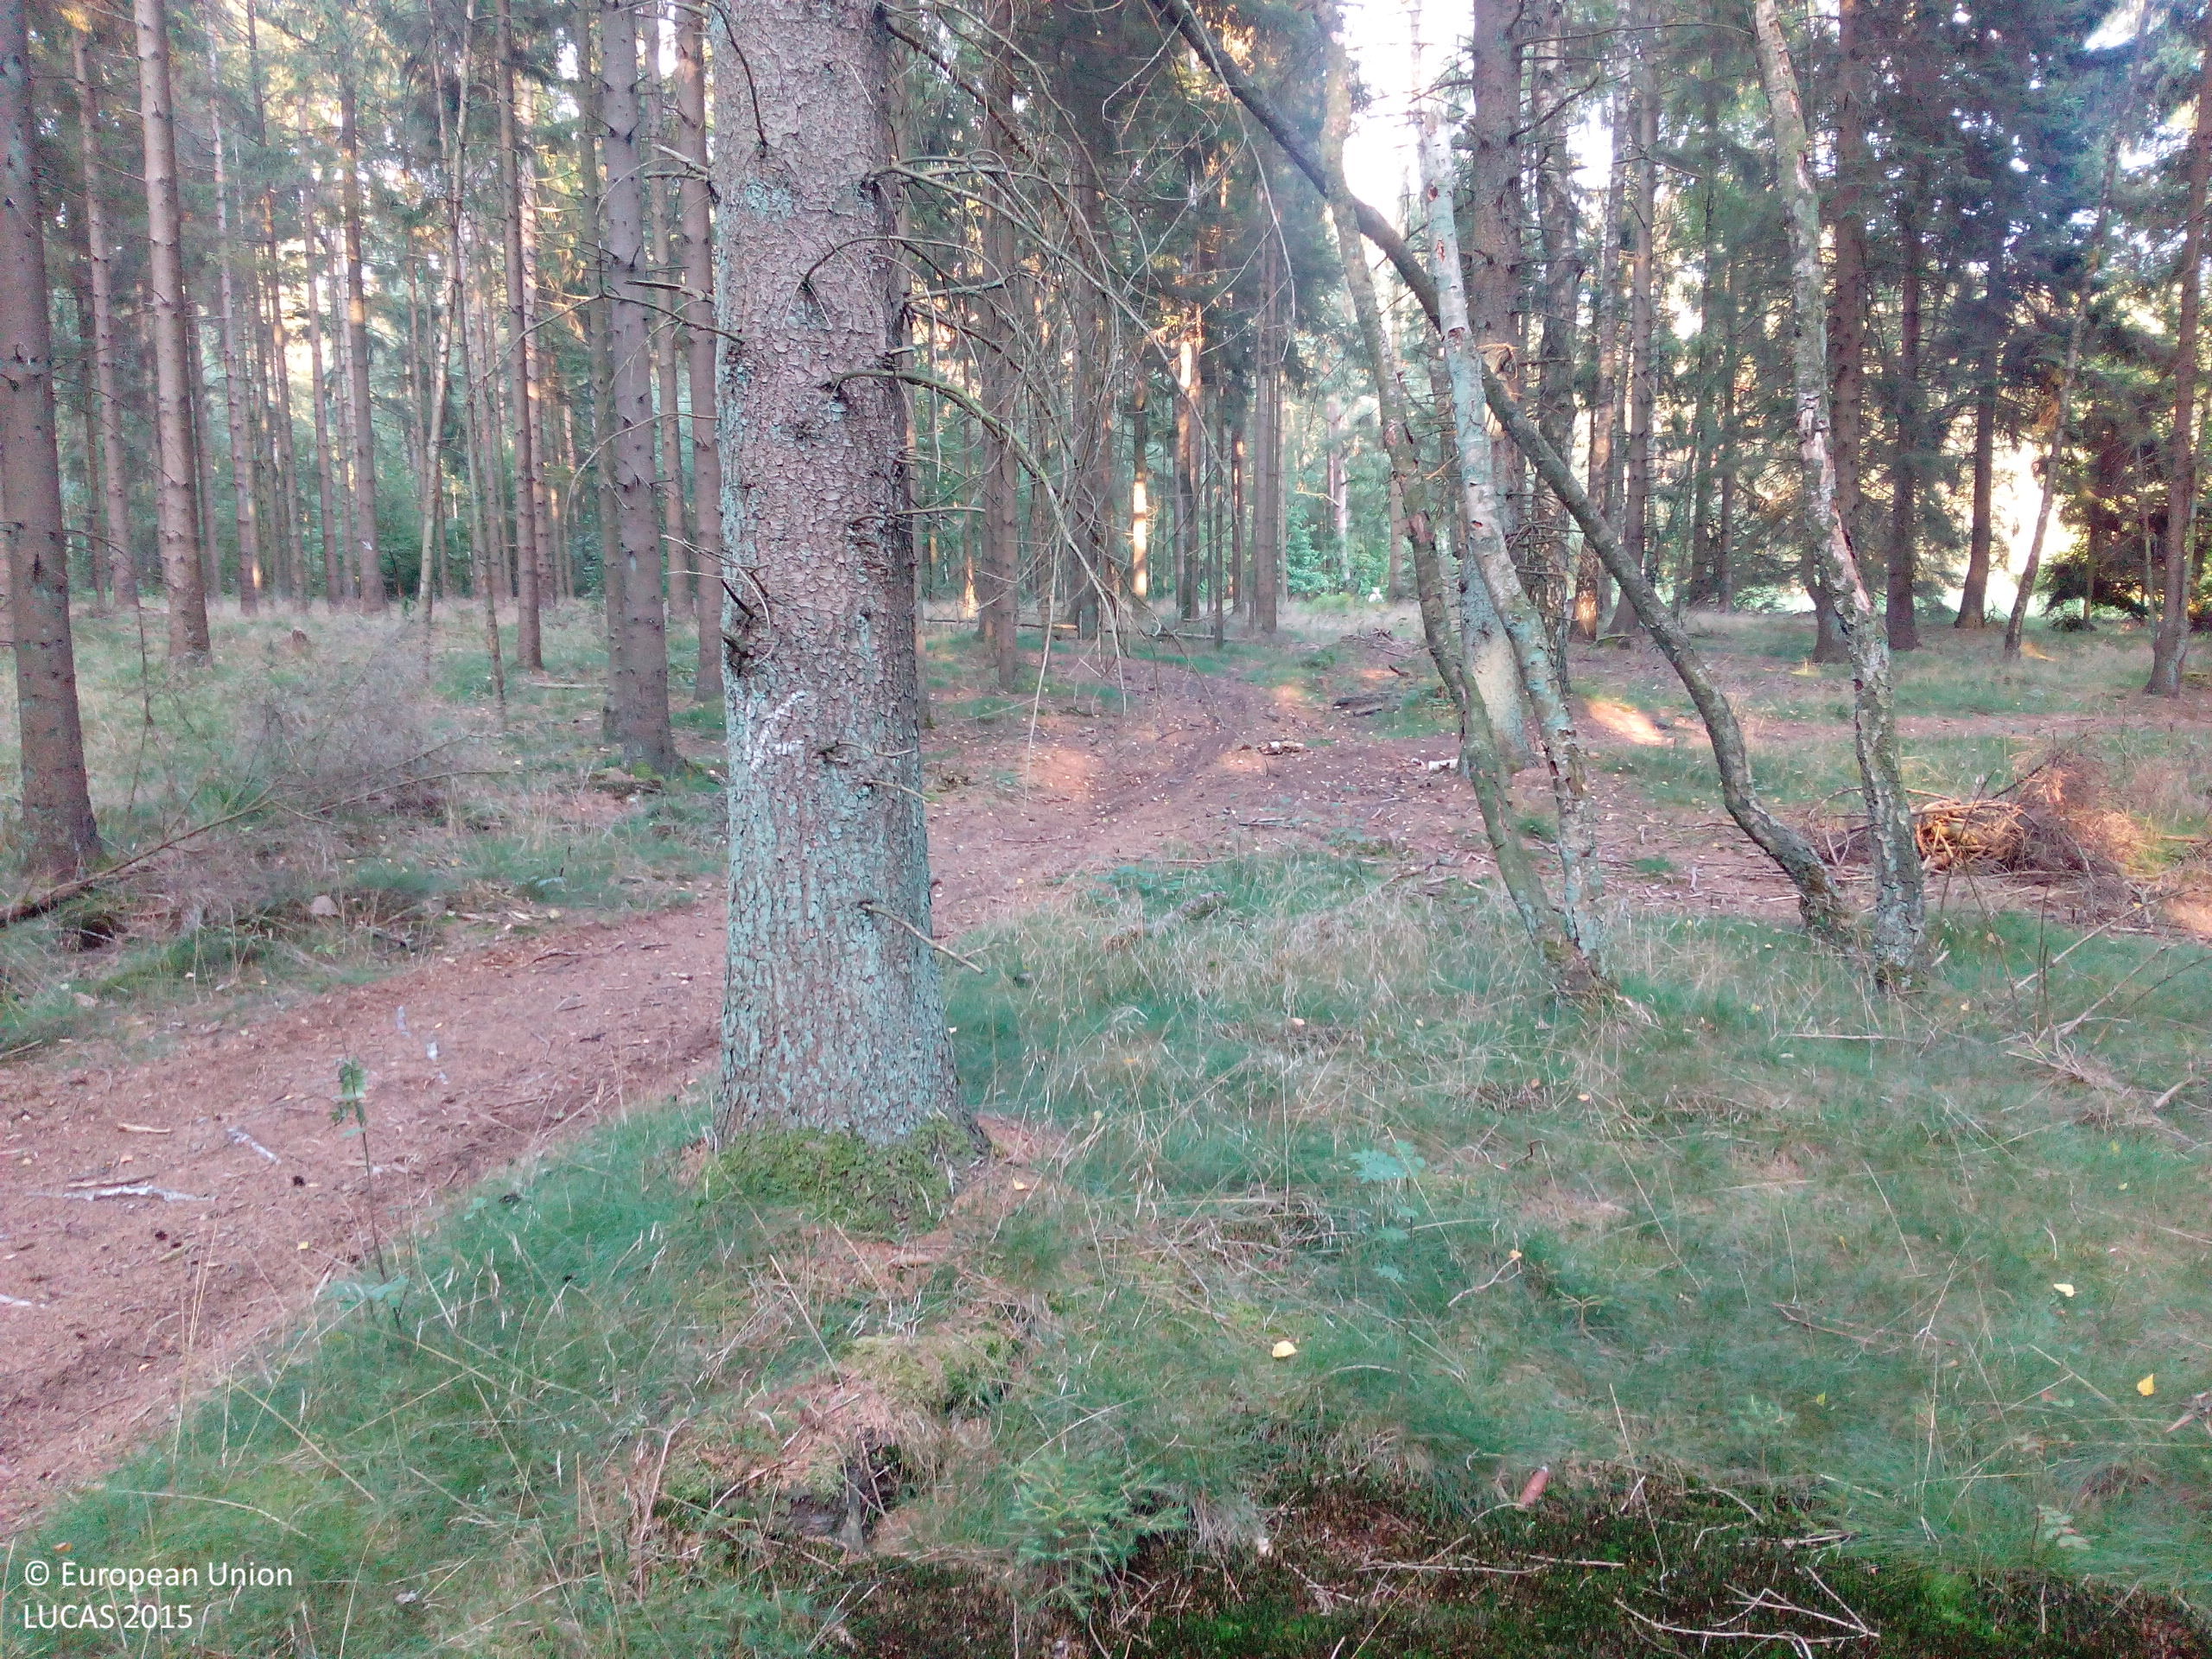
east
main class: Woodland
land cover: Spruce dominated coniferous woodland
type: hemiboreal forest and nemoral coniferous forest and mixed broadleaved-coniferous forest
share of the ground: > 75 %
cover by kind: coniferous forest trees 75 %, herbaceous plants 20 %, unconsolidated bare surface 5 %
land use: Forestry
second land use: Amenities, museums, leisure
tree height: > 5 m
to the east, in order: Spruce dominated coniferous woodland; Tracks; Pine dominated coniferous woodland; Tracks; Spontaneously vegetated surfaces; Pine dominated coniferous woodland
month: August
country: DE
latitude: 53.8152
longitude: 9.8937
